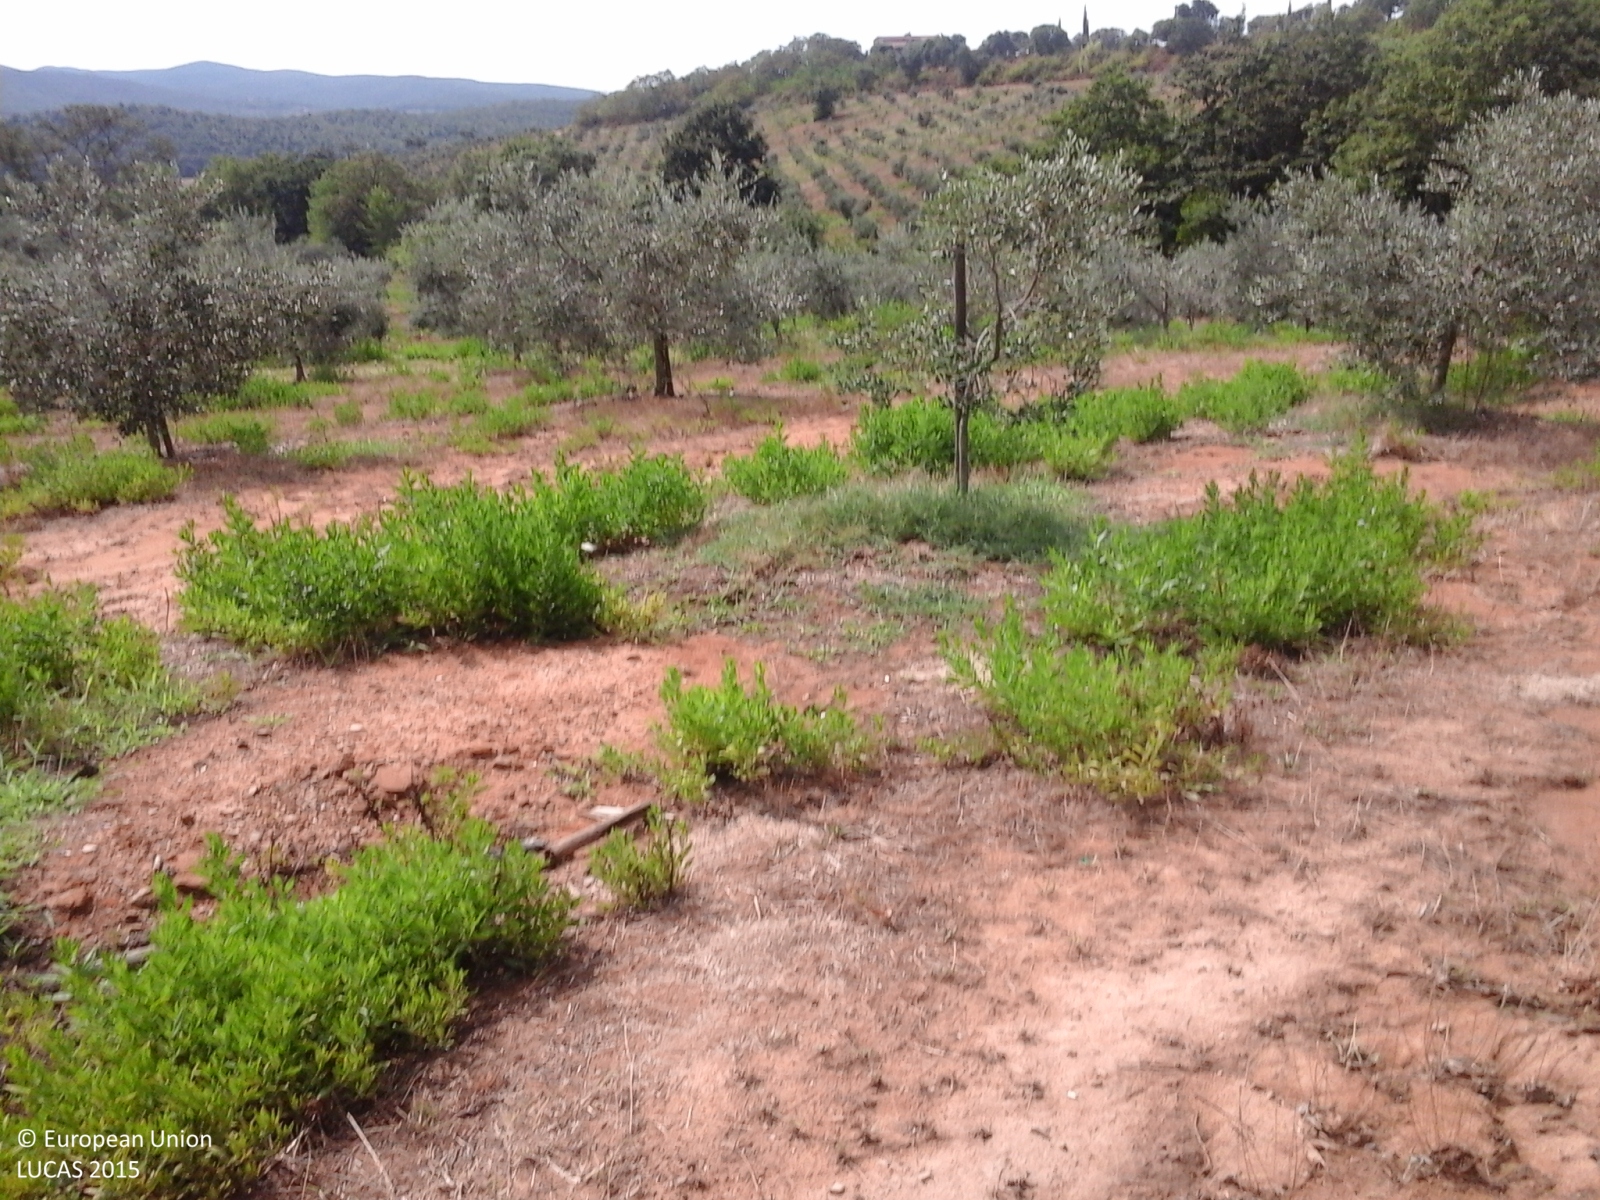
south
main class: Cropland
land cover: Olive groves
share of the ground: 50 - 75 %
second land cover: Spontaneously vegetated surfaces
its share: 25 - 50 %
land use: Agriculture (excluding fallow land and kitchen gardens)
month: August
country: IT
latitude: 42.8844
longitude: 10.9398
